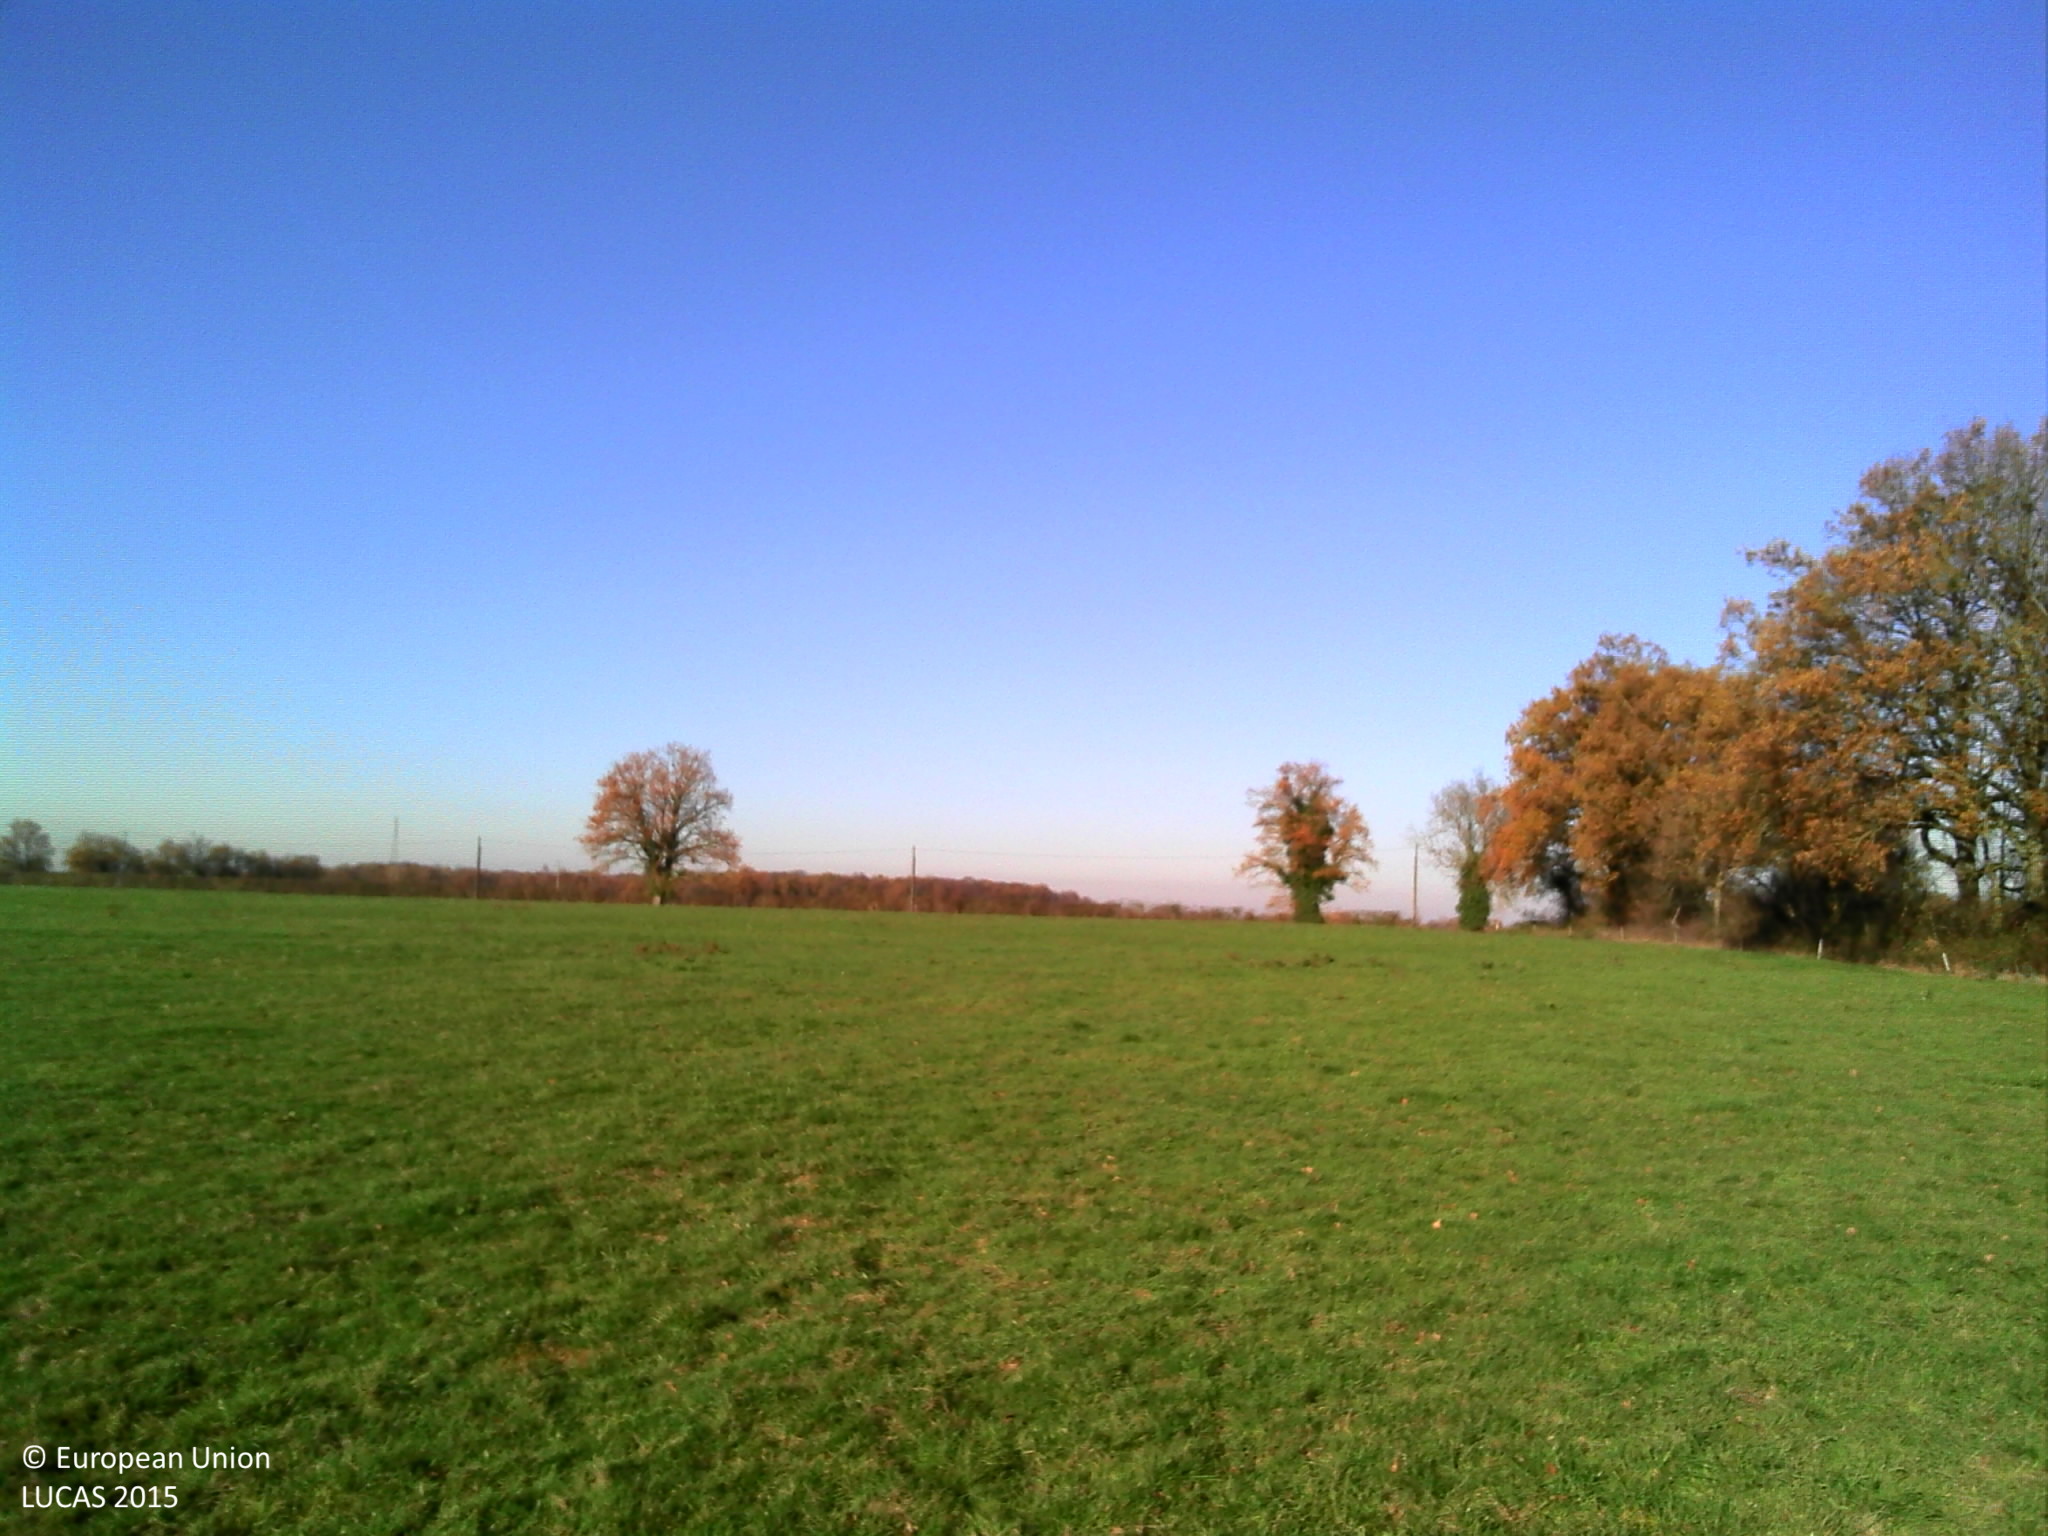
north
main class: Grassland
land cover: Grassland without tree/shrub cover
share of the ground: > 75 %
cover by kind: herbaceous plants 100 %
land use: Agriculture (excluding fallow land and kitchen gardens)
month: December
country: FR
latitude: 46.0323
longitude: 4.9255
